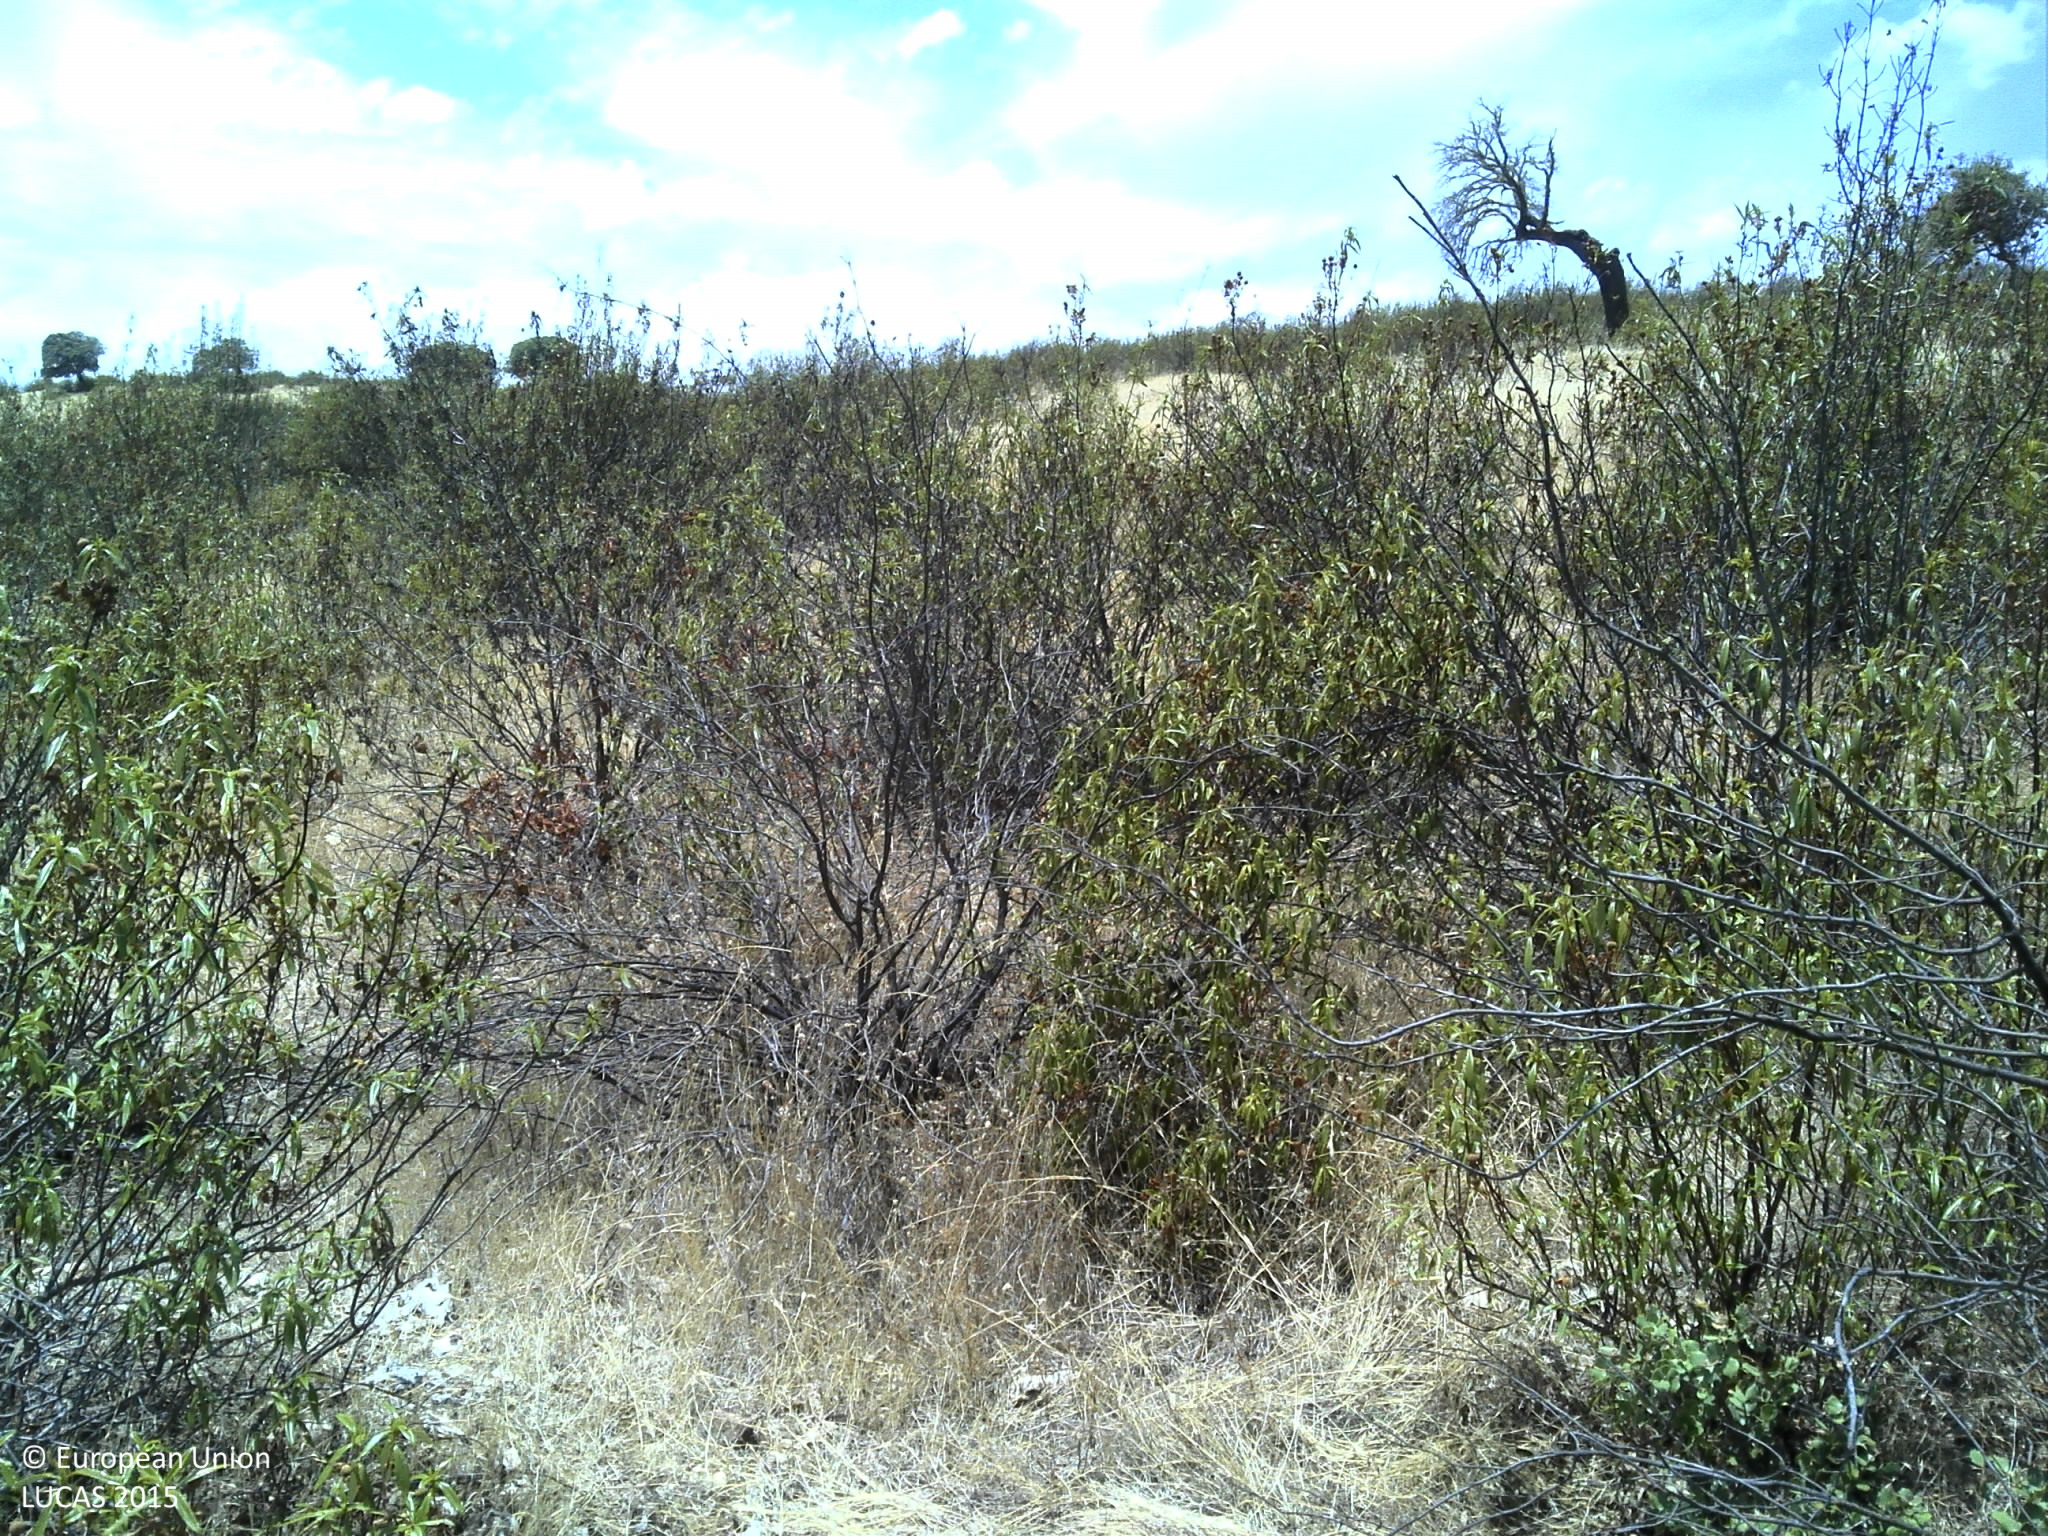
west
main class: Shrubland
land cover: Shrubland without tree cover
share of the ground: 50 - 75 %
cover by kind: shrubs 80 %, herbaceous plants 20 %
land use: Abandoned areas
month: July
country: PT
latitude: 38.1075
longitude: -7.2015
